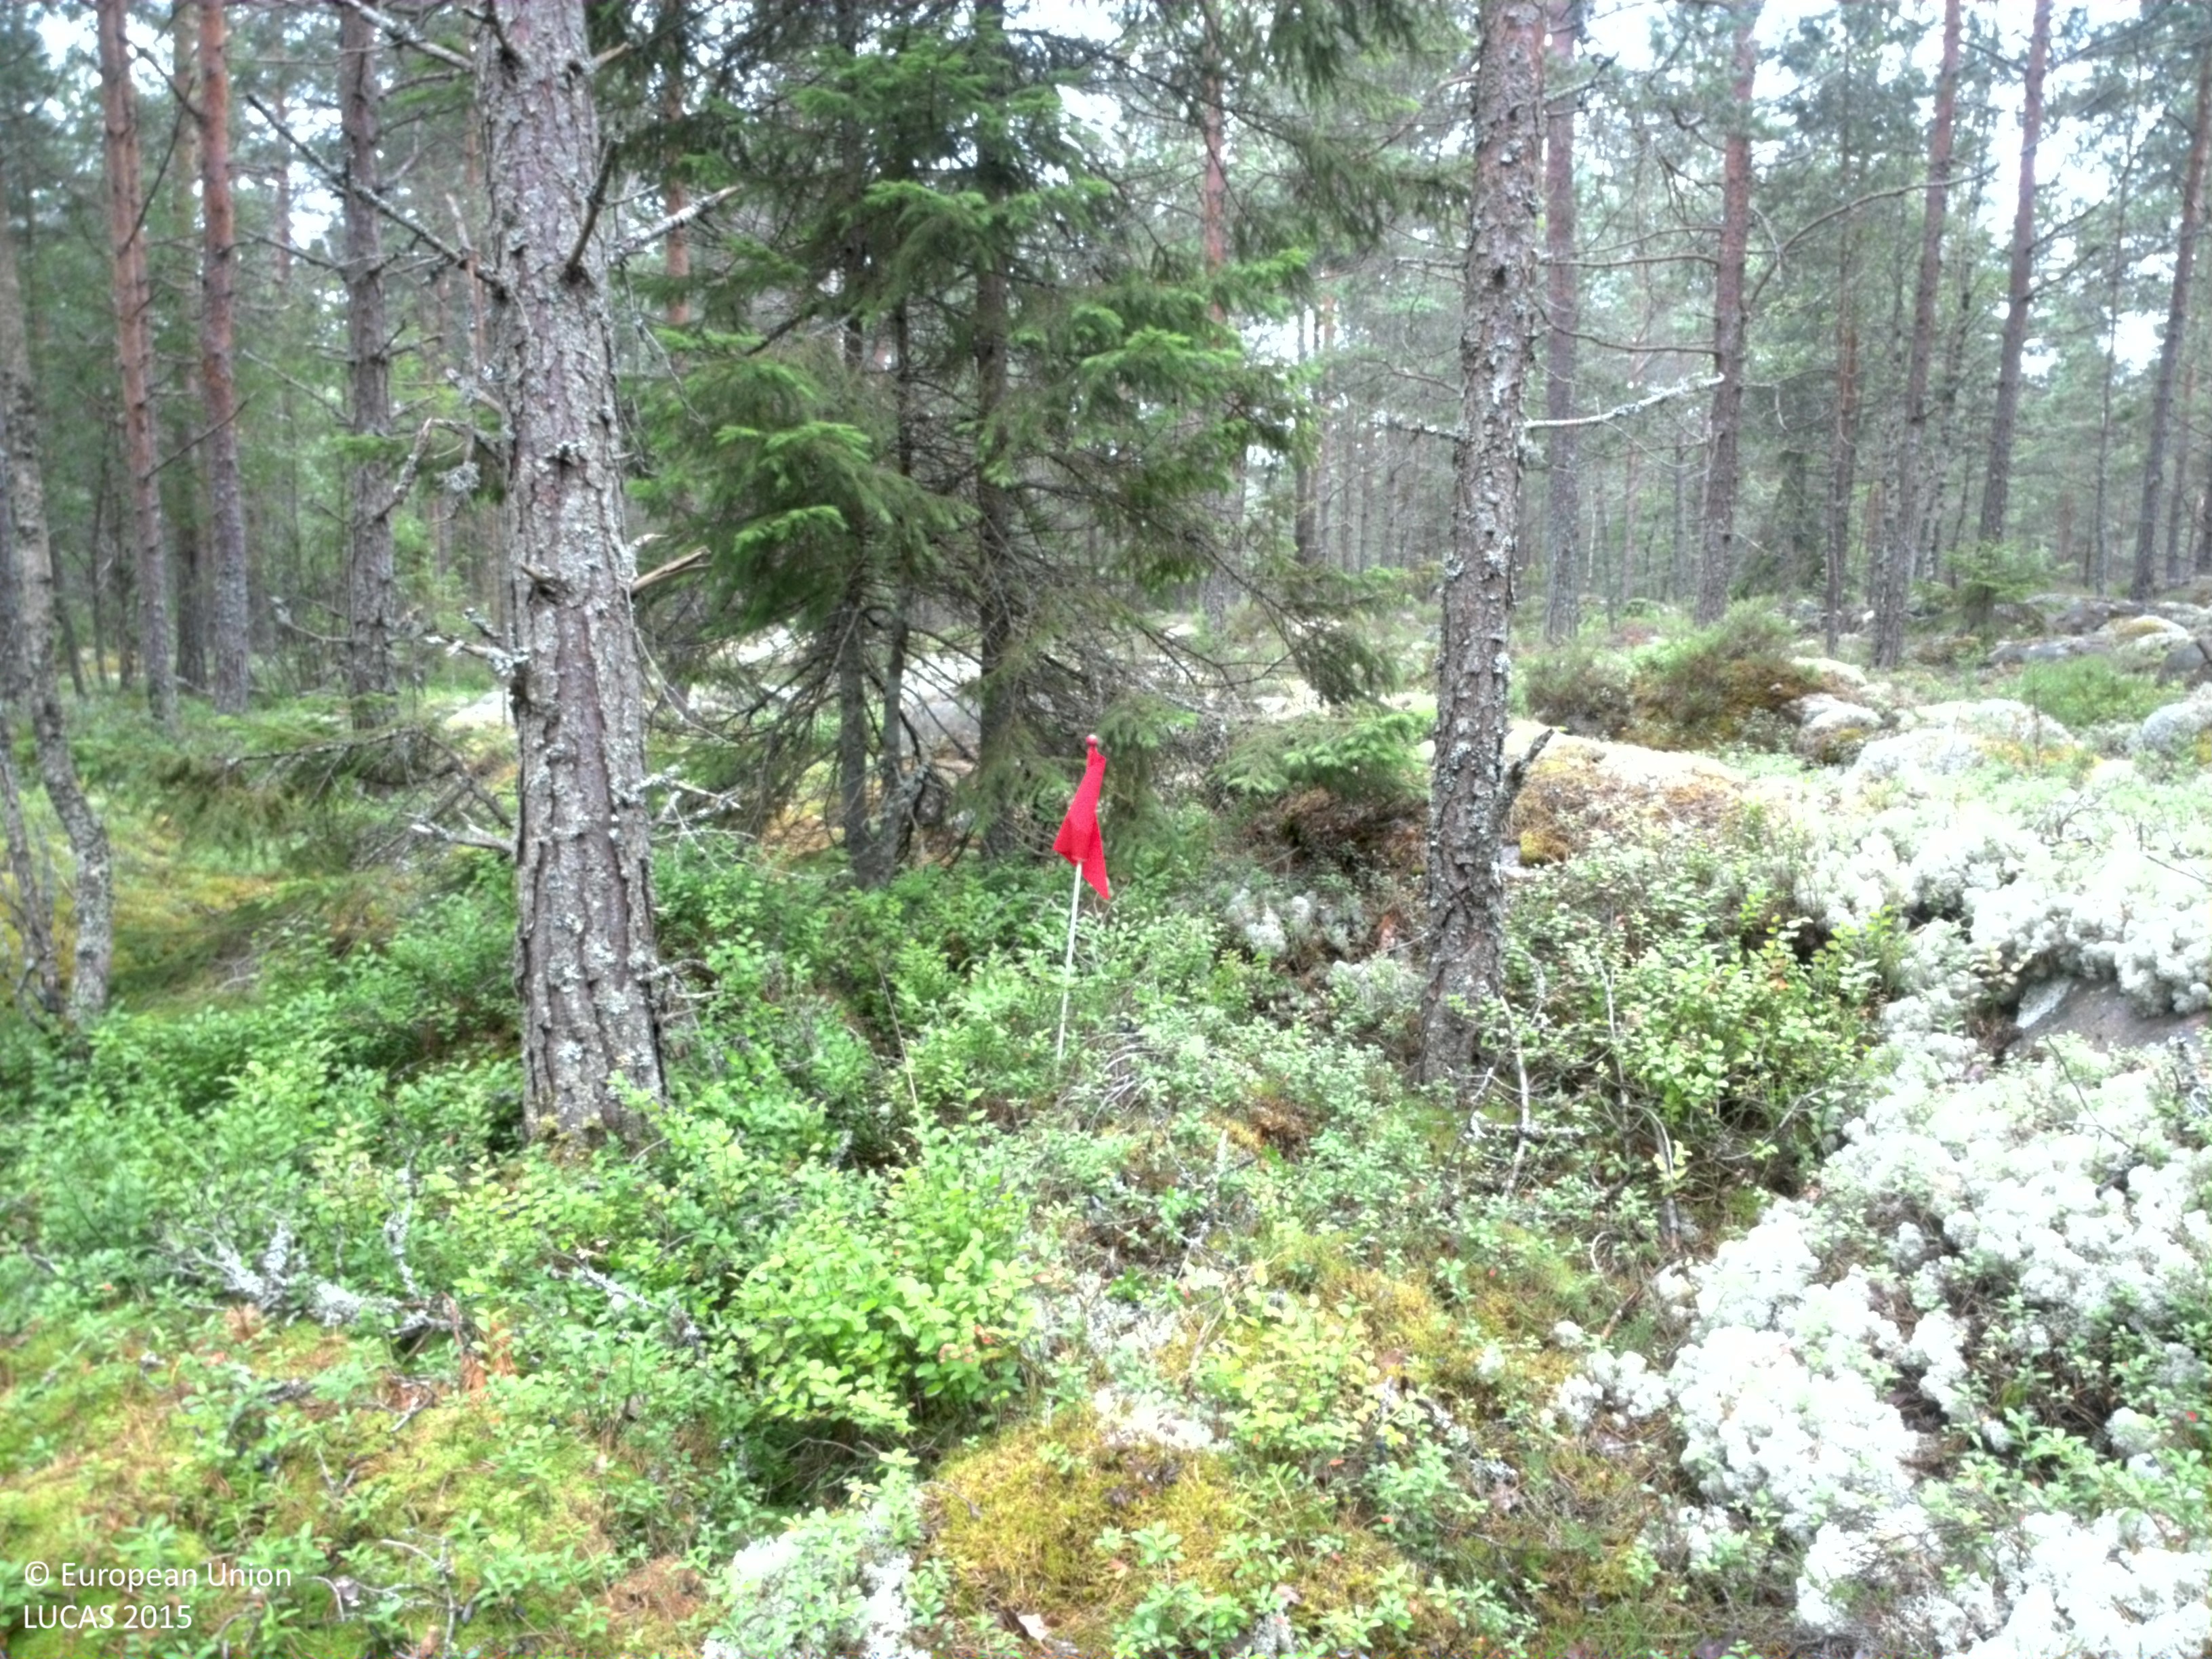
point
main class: Woodland
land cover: Pine dominated coniferous woodland
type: boreal forest
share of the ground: 50 - 75 %
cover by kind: coniferous forest trees 55 %, shrubs 20 %, lichens and mosses 20 %, broadleaved forest trees 5 %
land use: Forestry
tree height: > 5 m
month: July
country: SE
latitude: 59.4397
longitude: 13.2897
